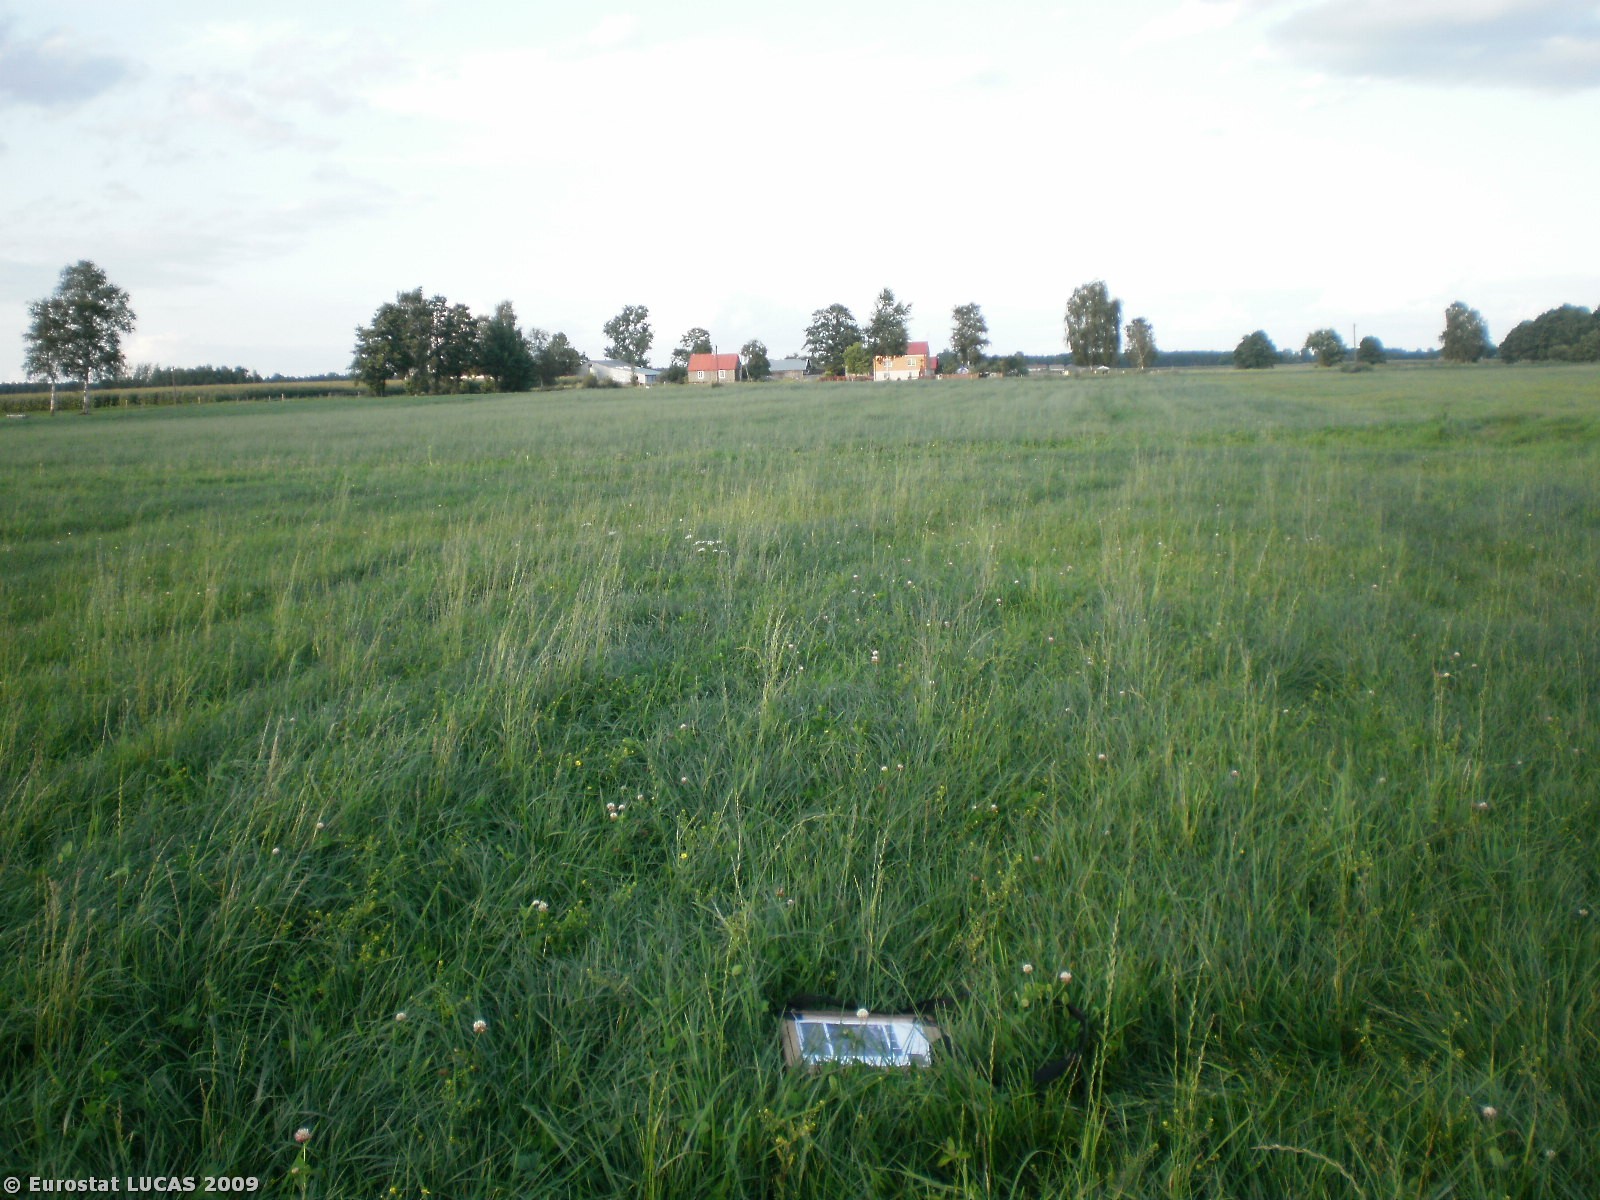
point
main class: Grassland
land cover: Grassland without tree/shrub cover
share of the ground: > 75 %
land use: Agriculture (excluding fallow land and kitchen gardens)
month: August
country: PL
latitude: 53.0873
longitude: 20.9274
